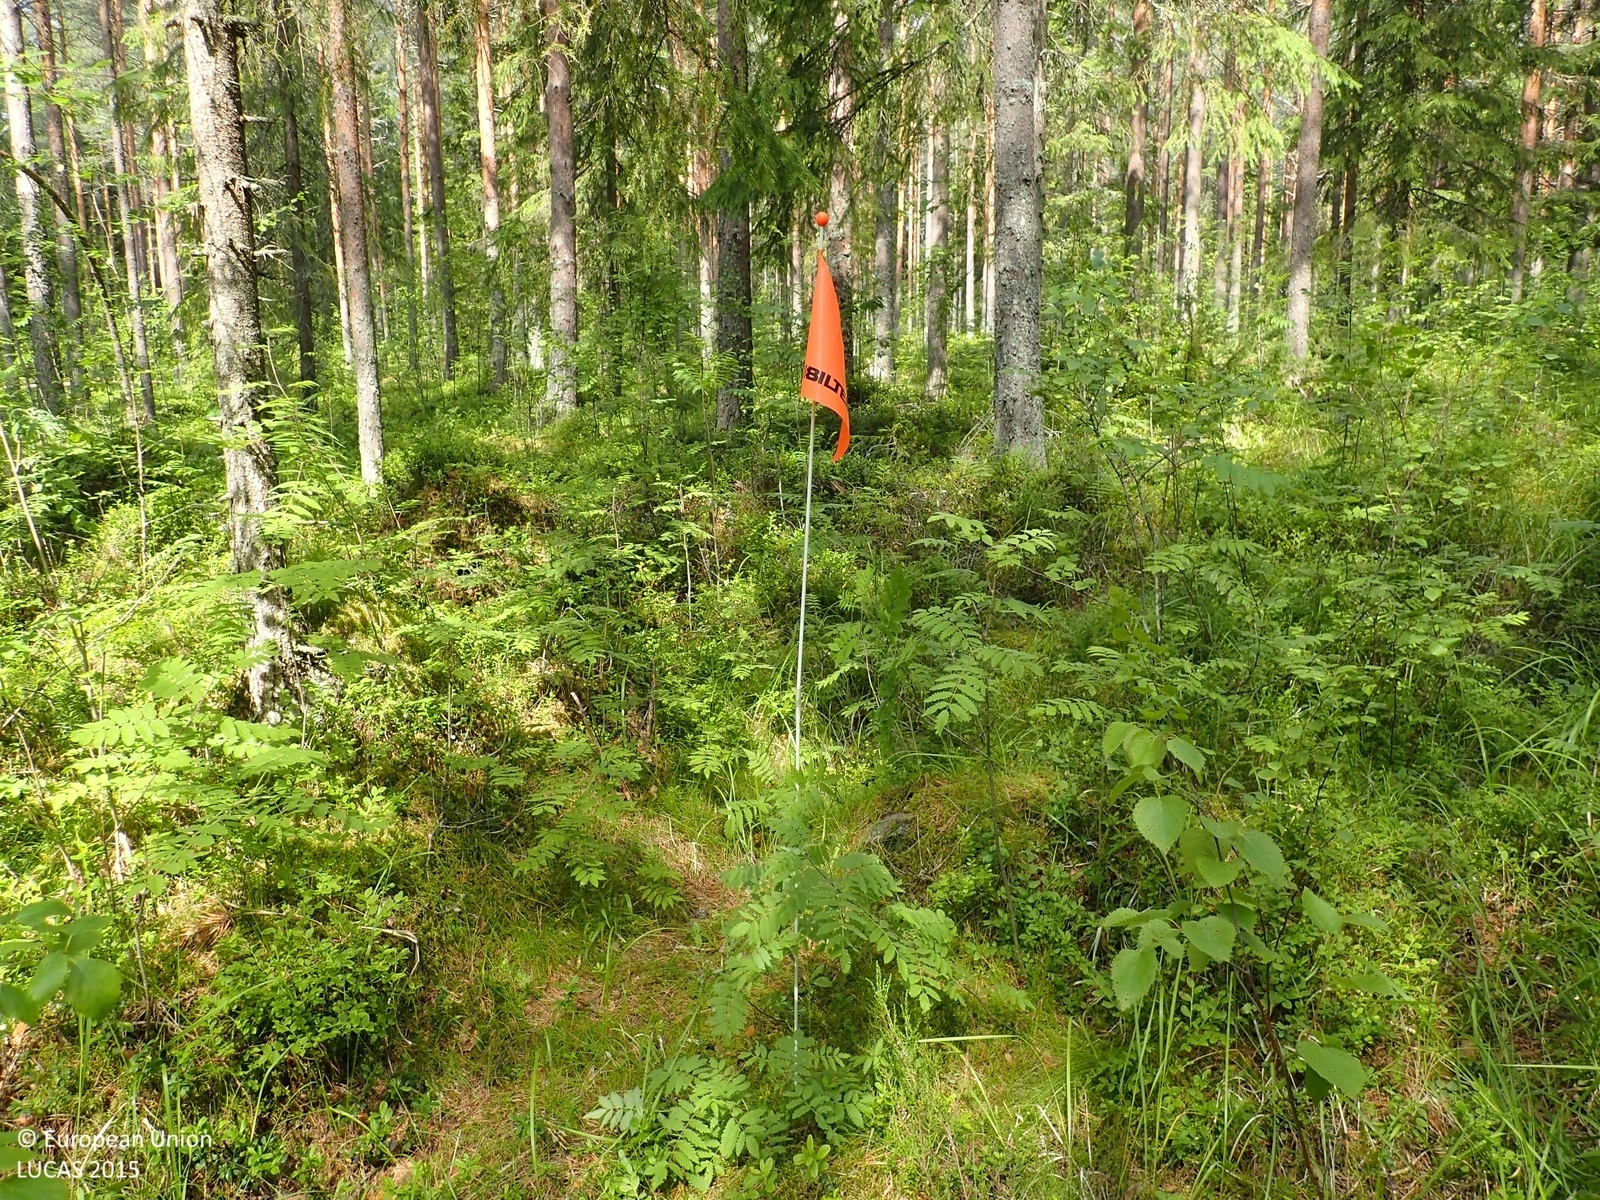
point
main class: Woodland
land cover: Pine dominated coniferous woodland
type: boreal forest
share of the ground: 50 - 75 %
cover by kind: coniferous forest trees 55 %, shrubs 30 %, broadleaved forest trees 10 %, herbaceous plants 5 %
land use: Forestry
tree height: > 5 m
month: July
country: FI
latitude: 62.7654
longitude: 23.5651
